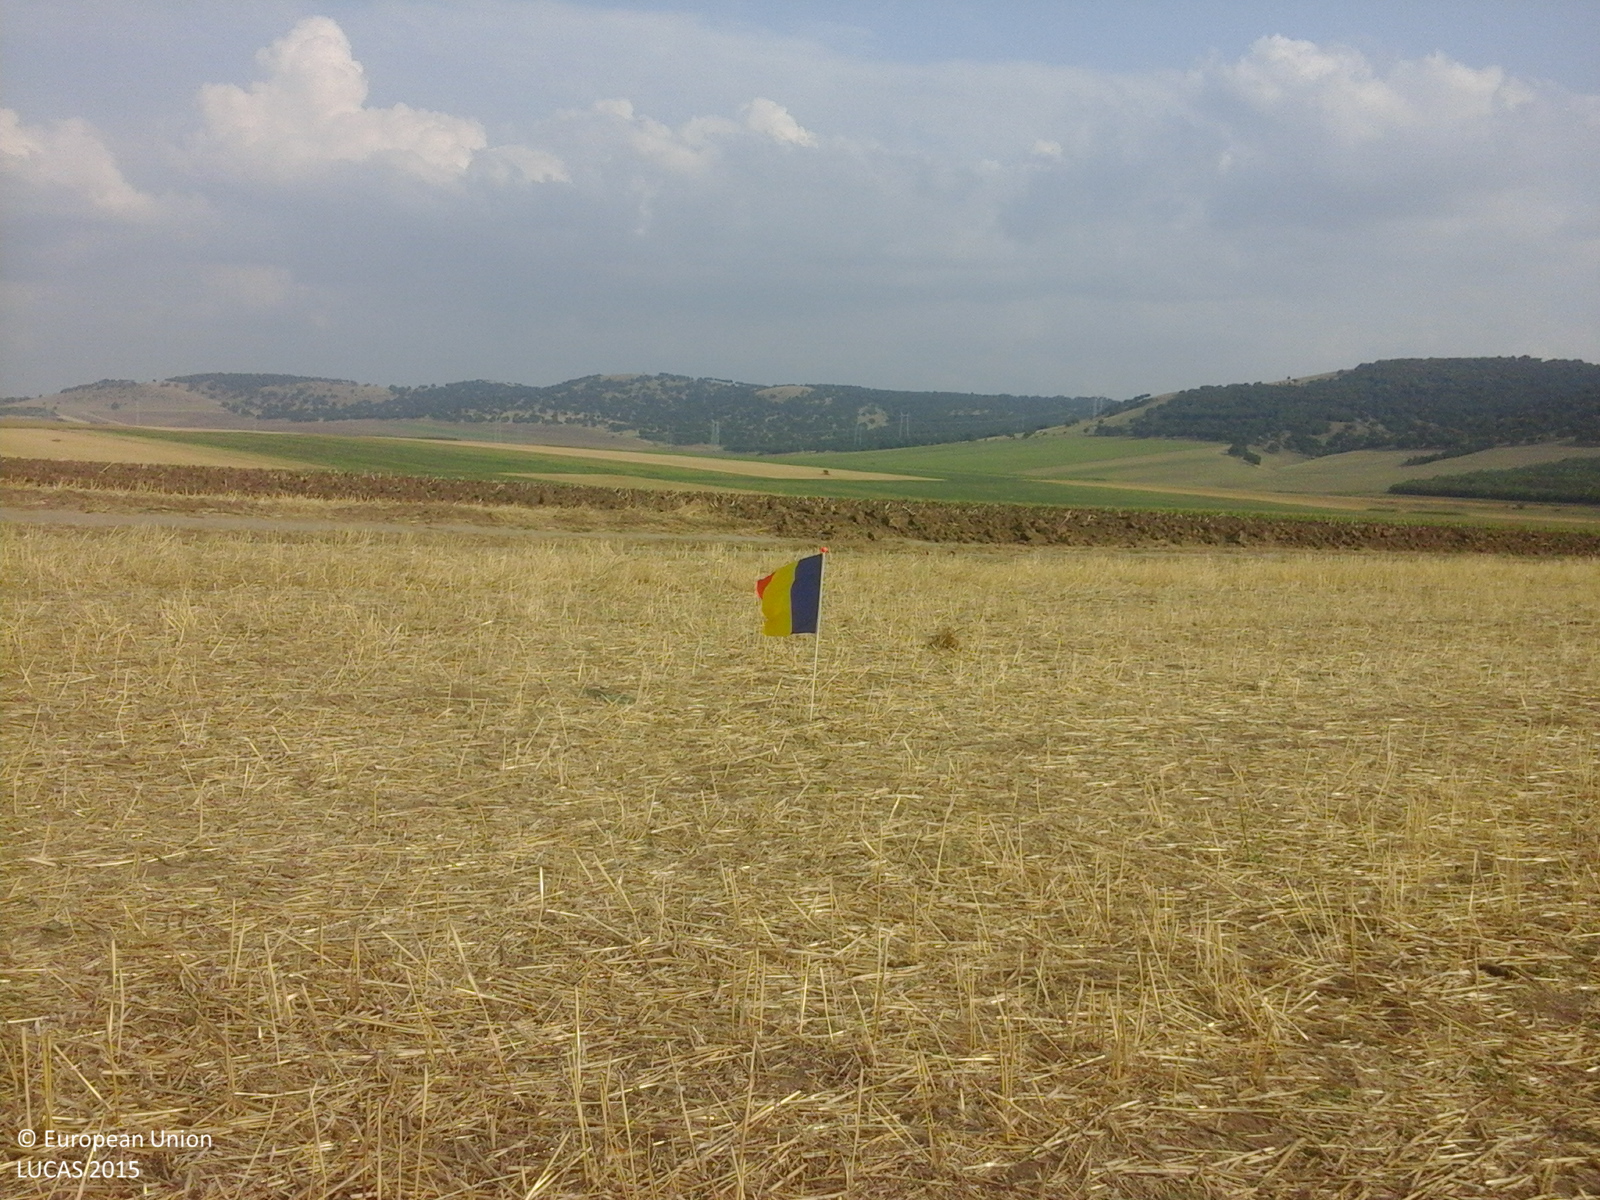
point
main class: Cropland
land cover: Common wheat
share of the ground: 50 - 75 %
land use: Agriculture (excluding fallow land and kitchen gardens)
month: July
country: RO
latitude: 45.0252
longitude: 28.3360
